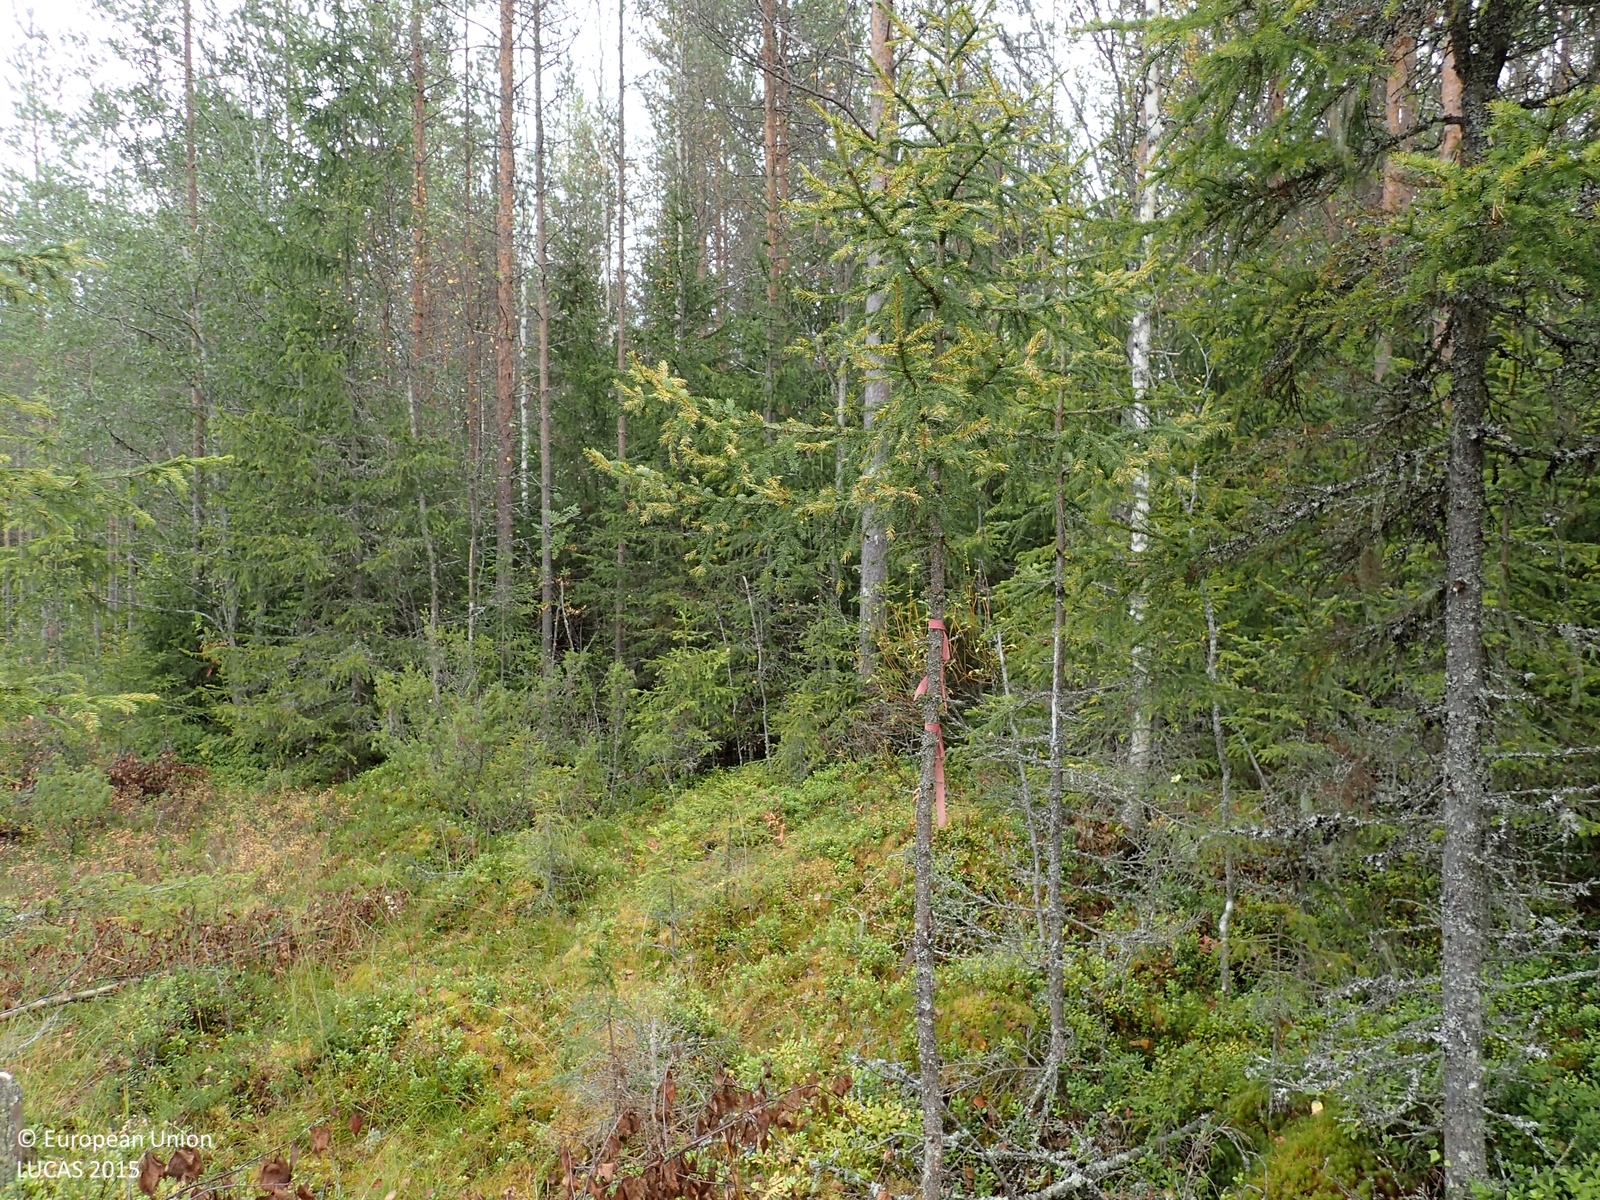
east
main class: Woodland
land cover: Spruce dominated coniferous woodland
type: boreal forest
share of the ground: 50 - 75 %
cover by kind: coniferous forest trees 50 %, shrubs 45 %, lichens and mosses 5 %
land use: Forestry
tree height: < 5 m
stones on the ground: < 10 %
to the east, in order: Spruce dominated coniferous woodland; Pine dominated coniferous woodland; Spruce dominated mixed woodland; Pine dominated mixed woodland; Ditches and canals; Pine dominated mixed woodland; Ditches and canals; Pine dominated mixed woodland; Ditches and canals; Pine dominated mixed woodland
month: September
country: FI
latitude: 63.2874
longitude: 25.2319
